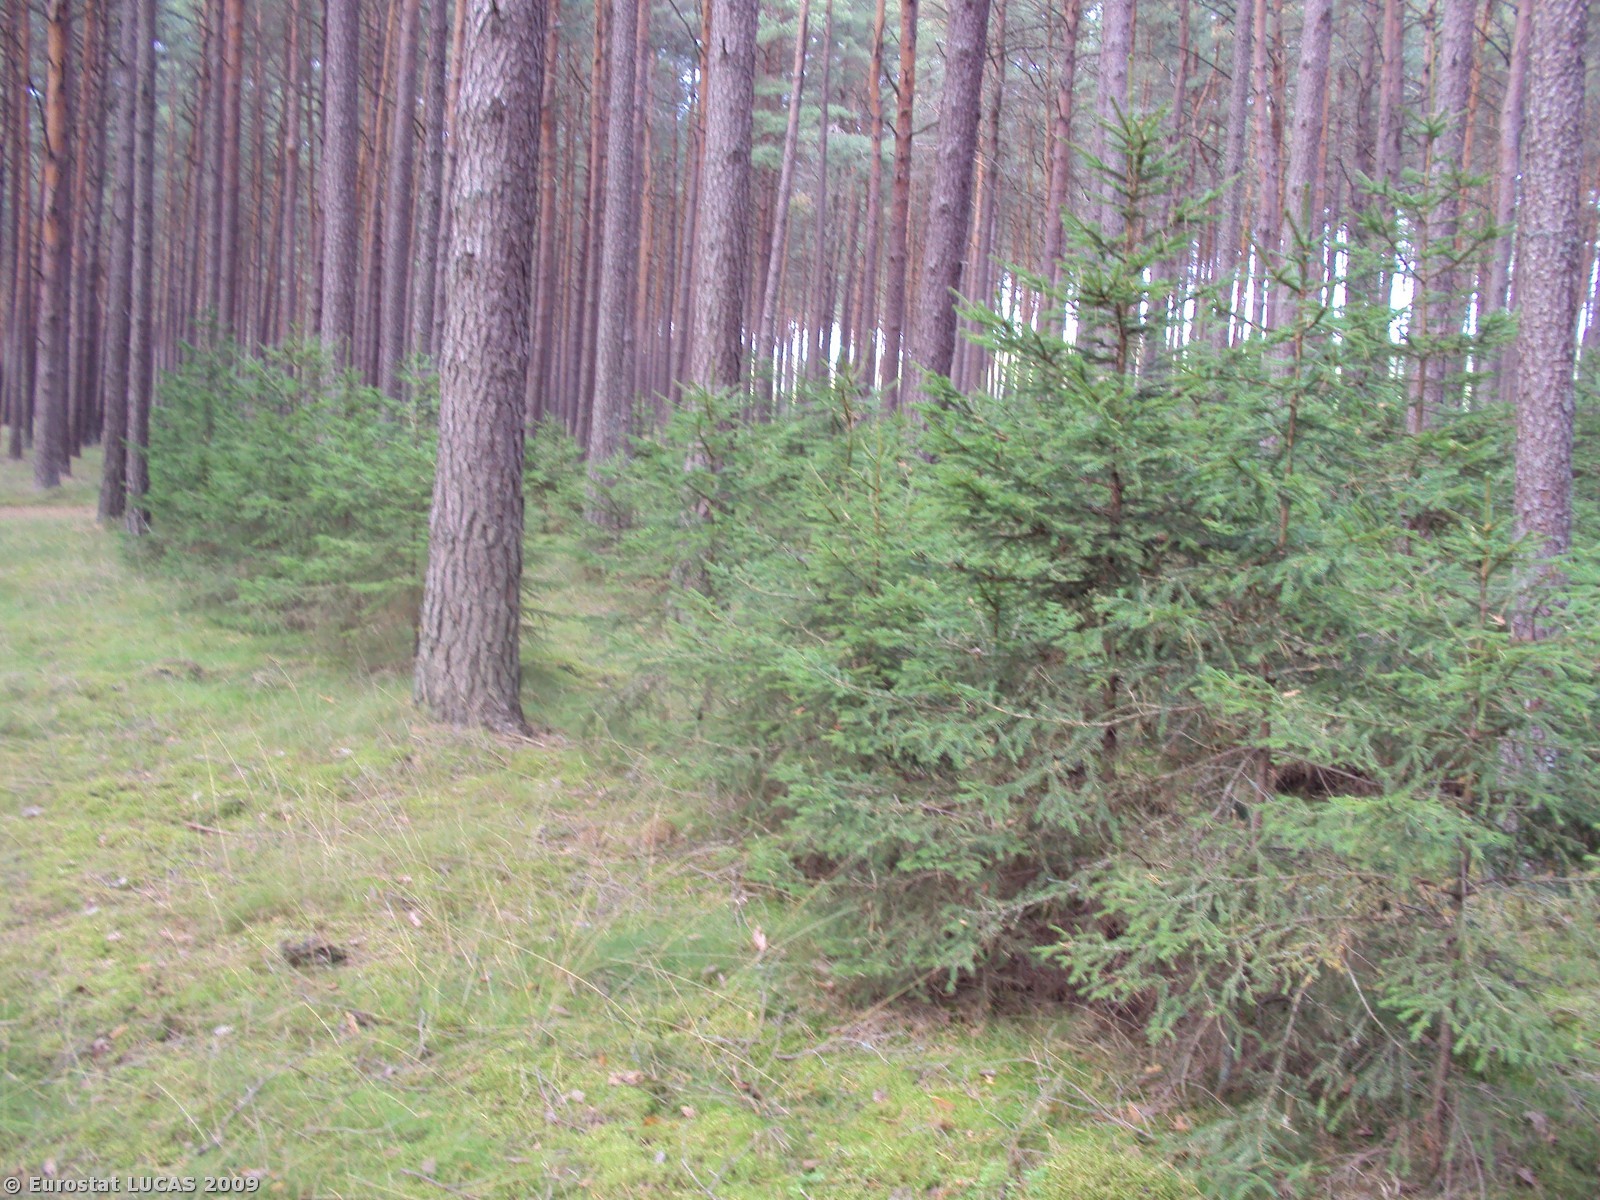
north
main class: Woodland
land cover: Coniferous woodland
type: hemiboreal forest and nemoral coniferous forest and mixed broadleaved-coniferous forest
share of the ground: > 75 %
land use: Forestry
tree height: > 5 m
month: September
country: PL
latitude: 53.3676
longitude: 16.5747
